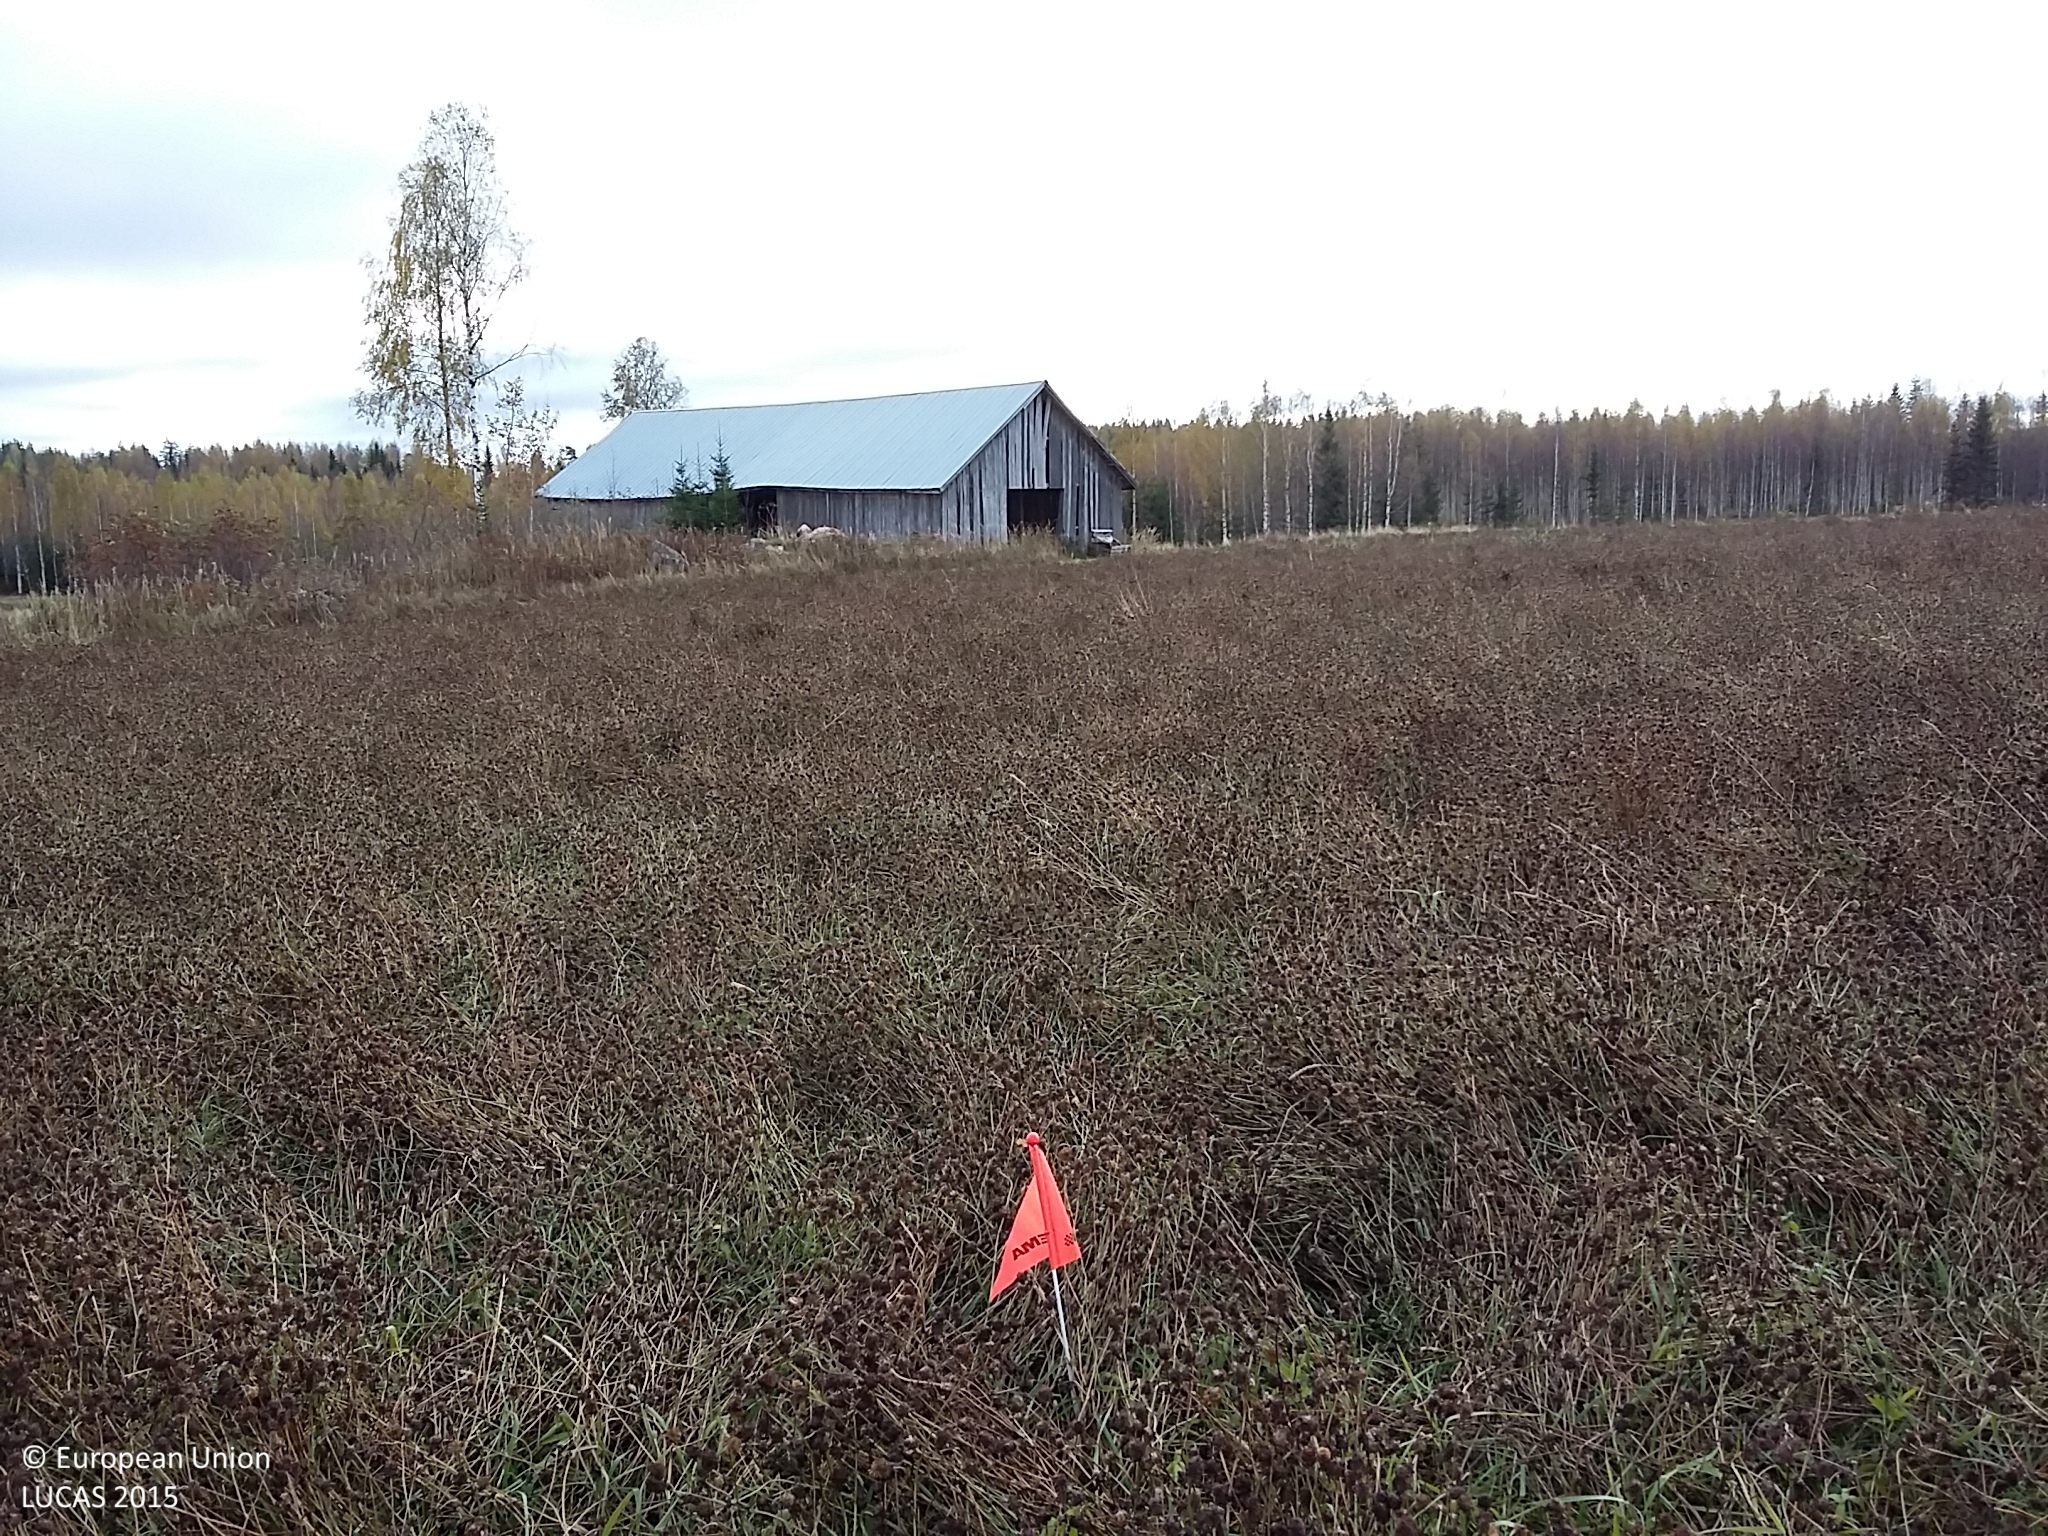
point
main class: Cropland
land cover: Other leguminous and mixtures for fodder
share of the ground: > 75 %
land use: Agriculture (excluding fallow land and kitchen gardens)
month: October
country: FI
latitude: 62.5481
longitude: 26.2891
